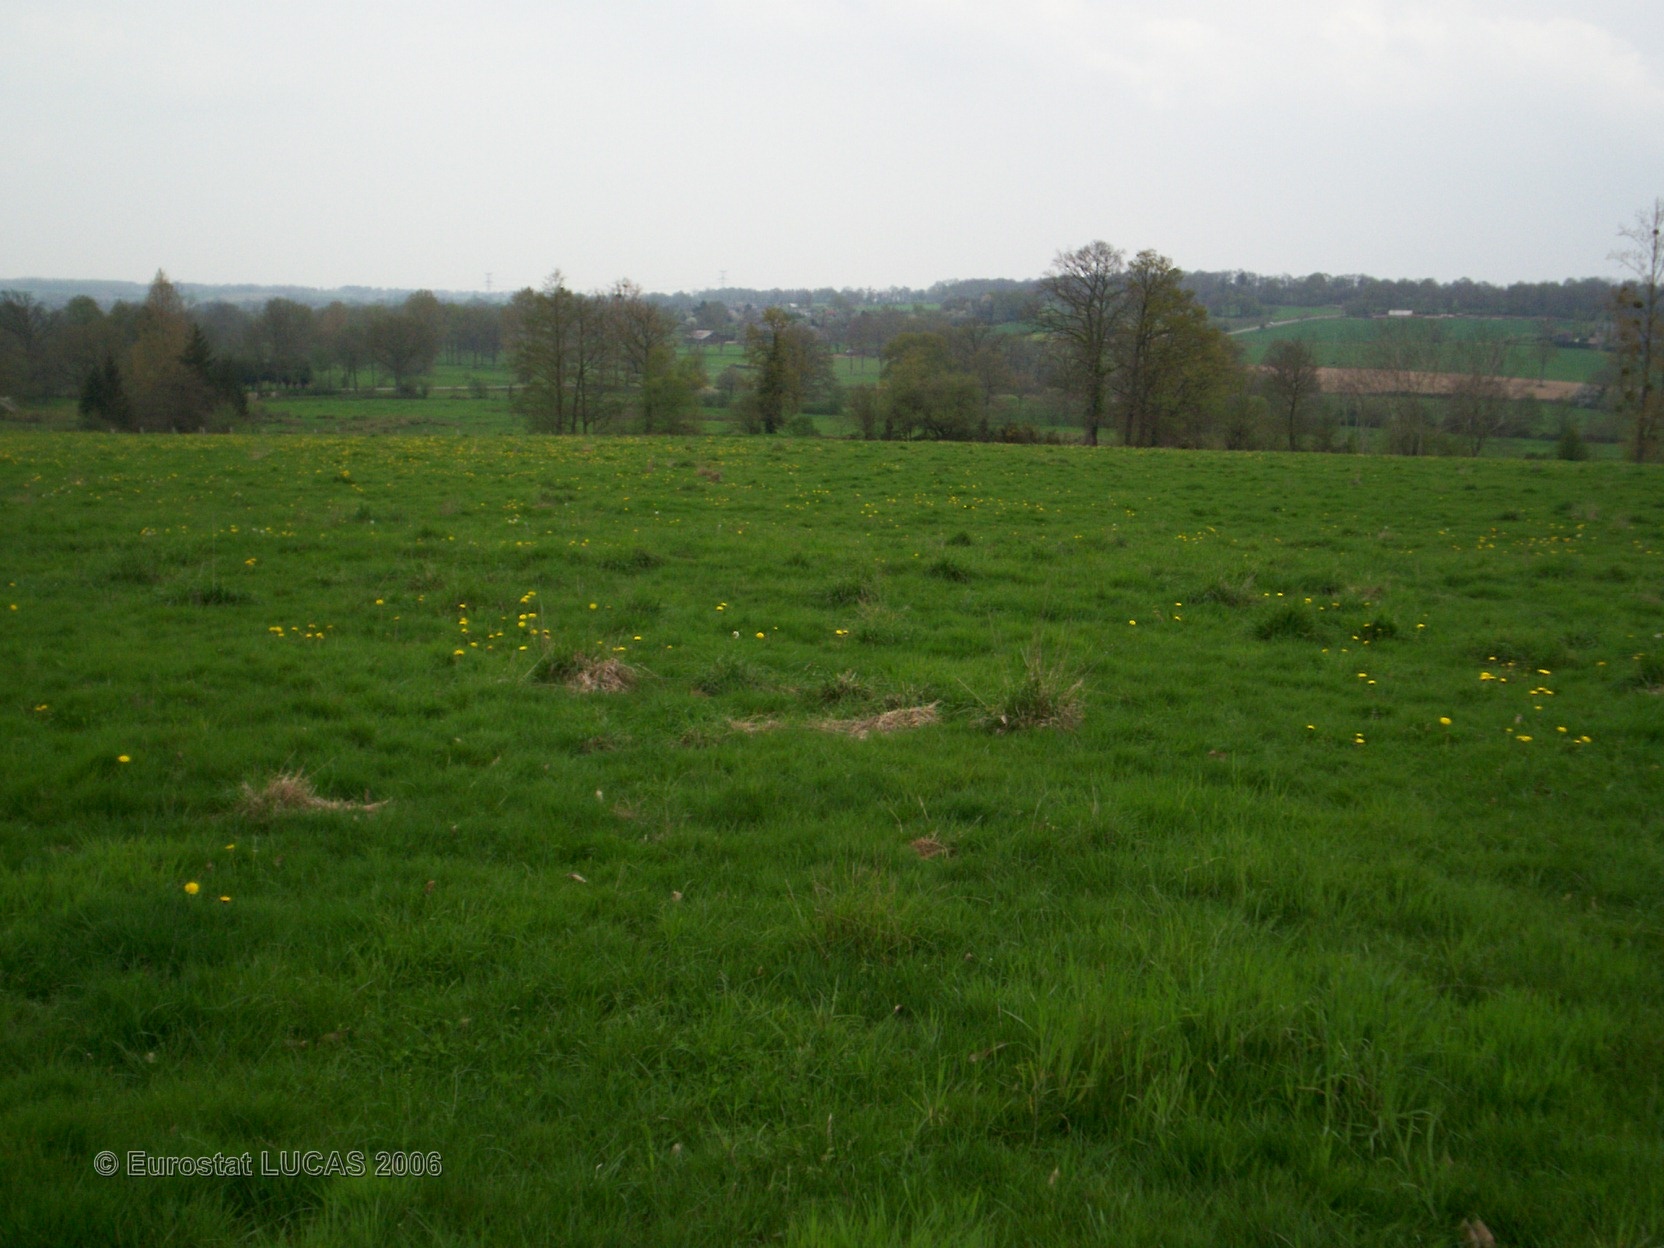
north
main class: Grassland
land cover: Grassland without tree/shrub cover
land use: Agriculture (excluding fallow land and kitchen gardens)
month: April
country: FR
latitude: 48.1976
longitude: -1.3589
